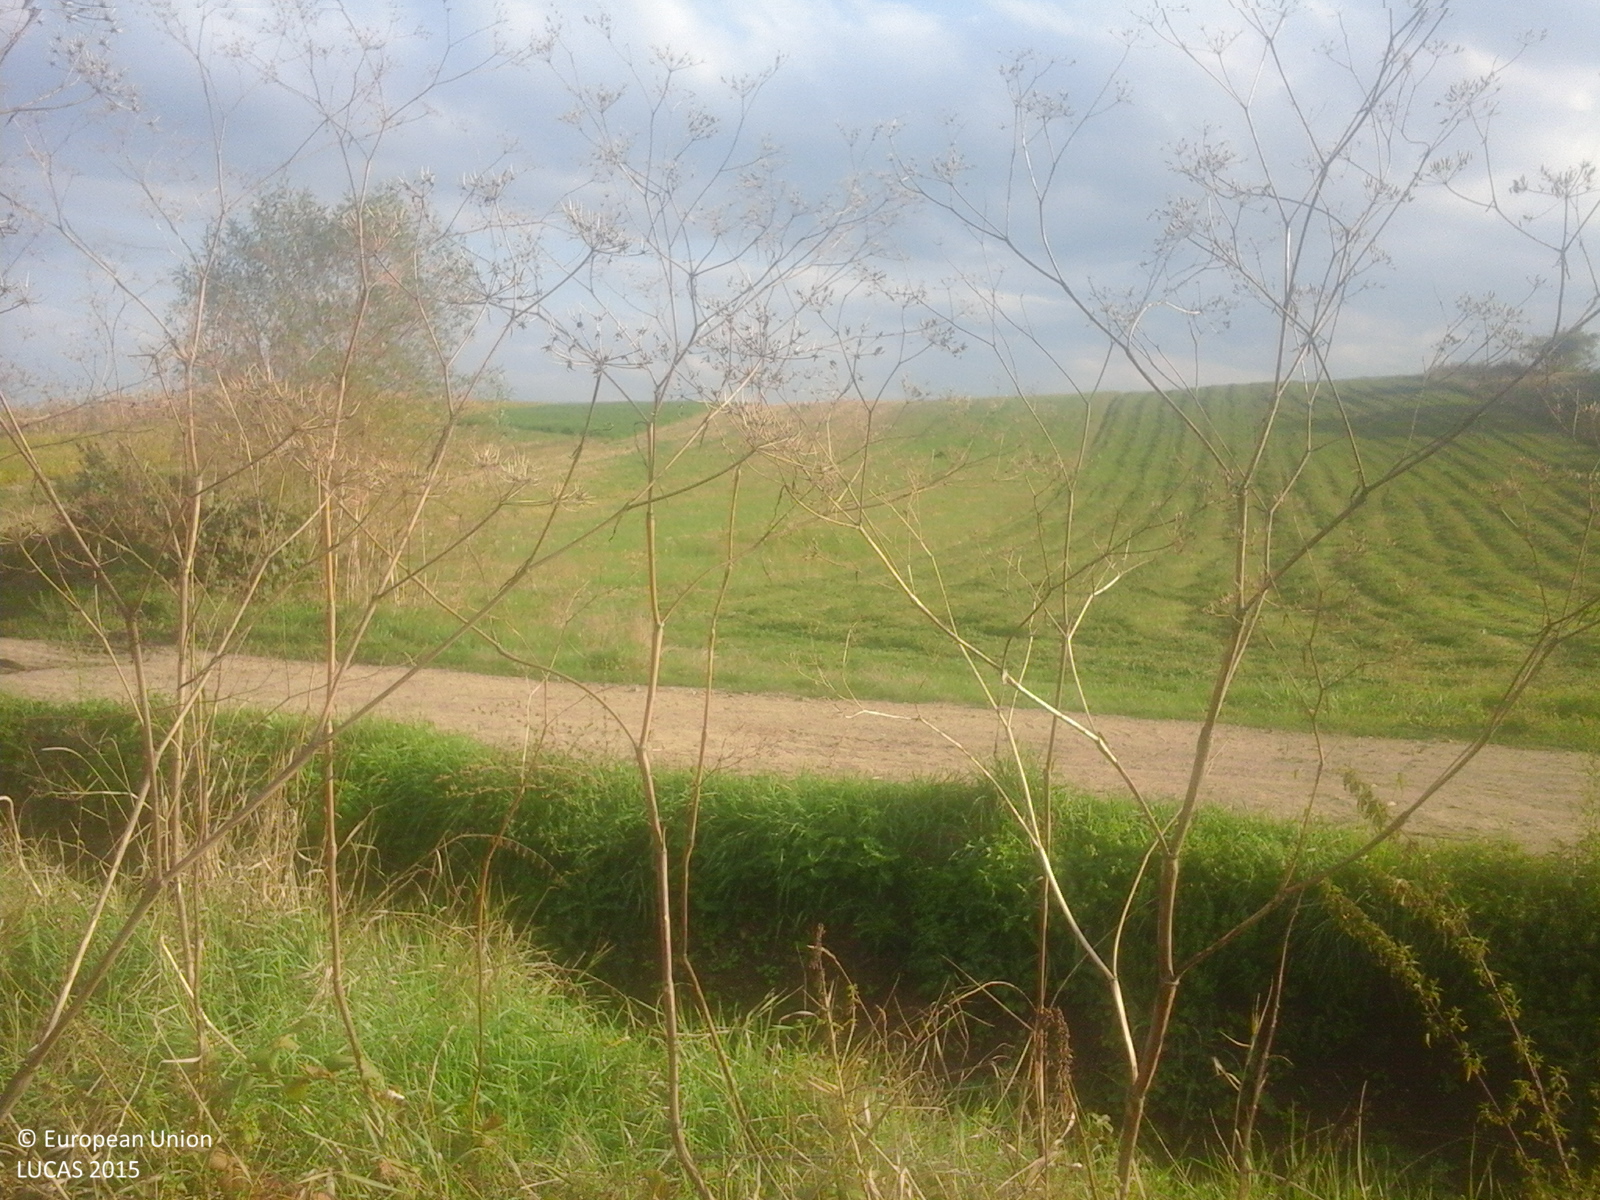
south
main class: Cropland
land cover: Sunflower
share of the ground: > 75 %
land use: Agriculture (excluding fallow land and kitchen gardens)
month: September
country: RO
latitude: 47.3213
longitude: 22.8556
